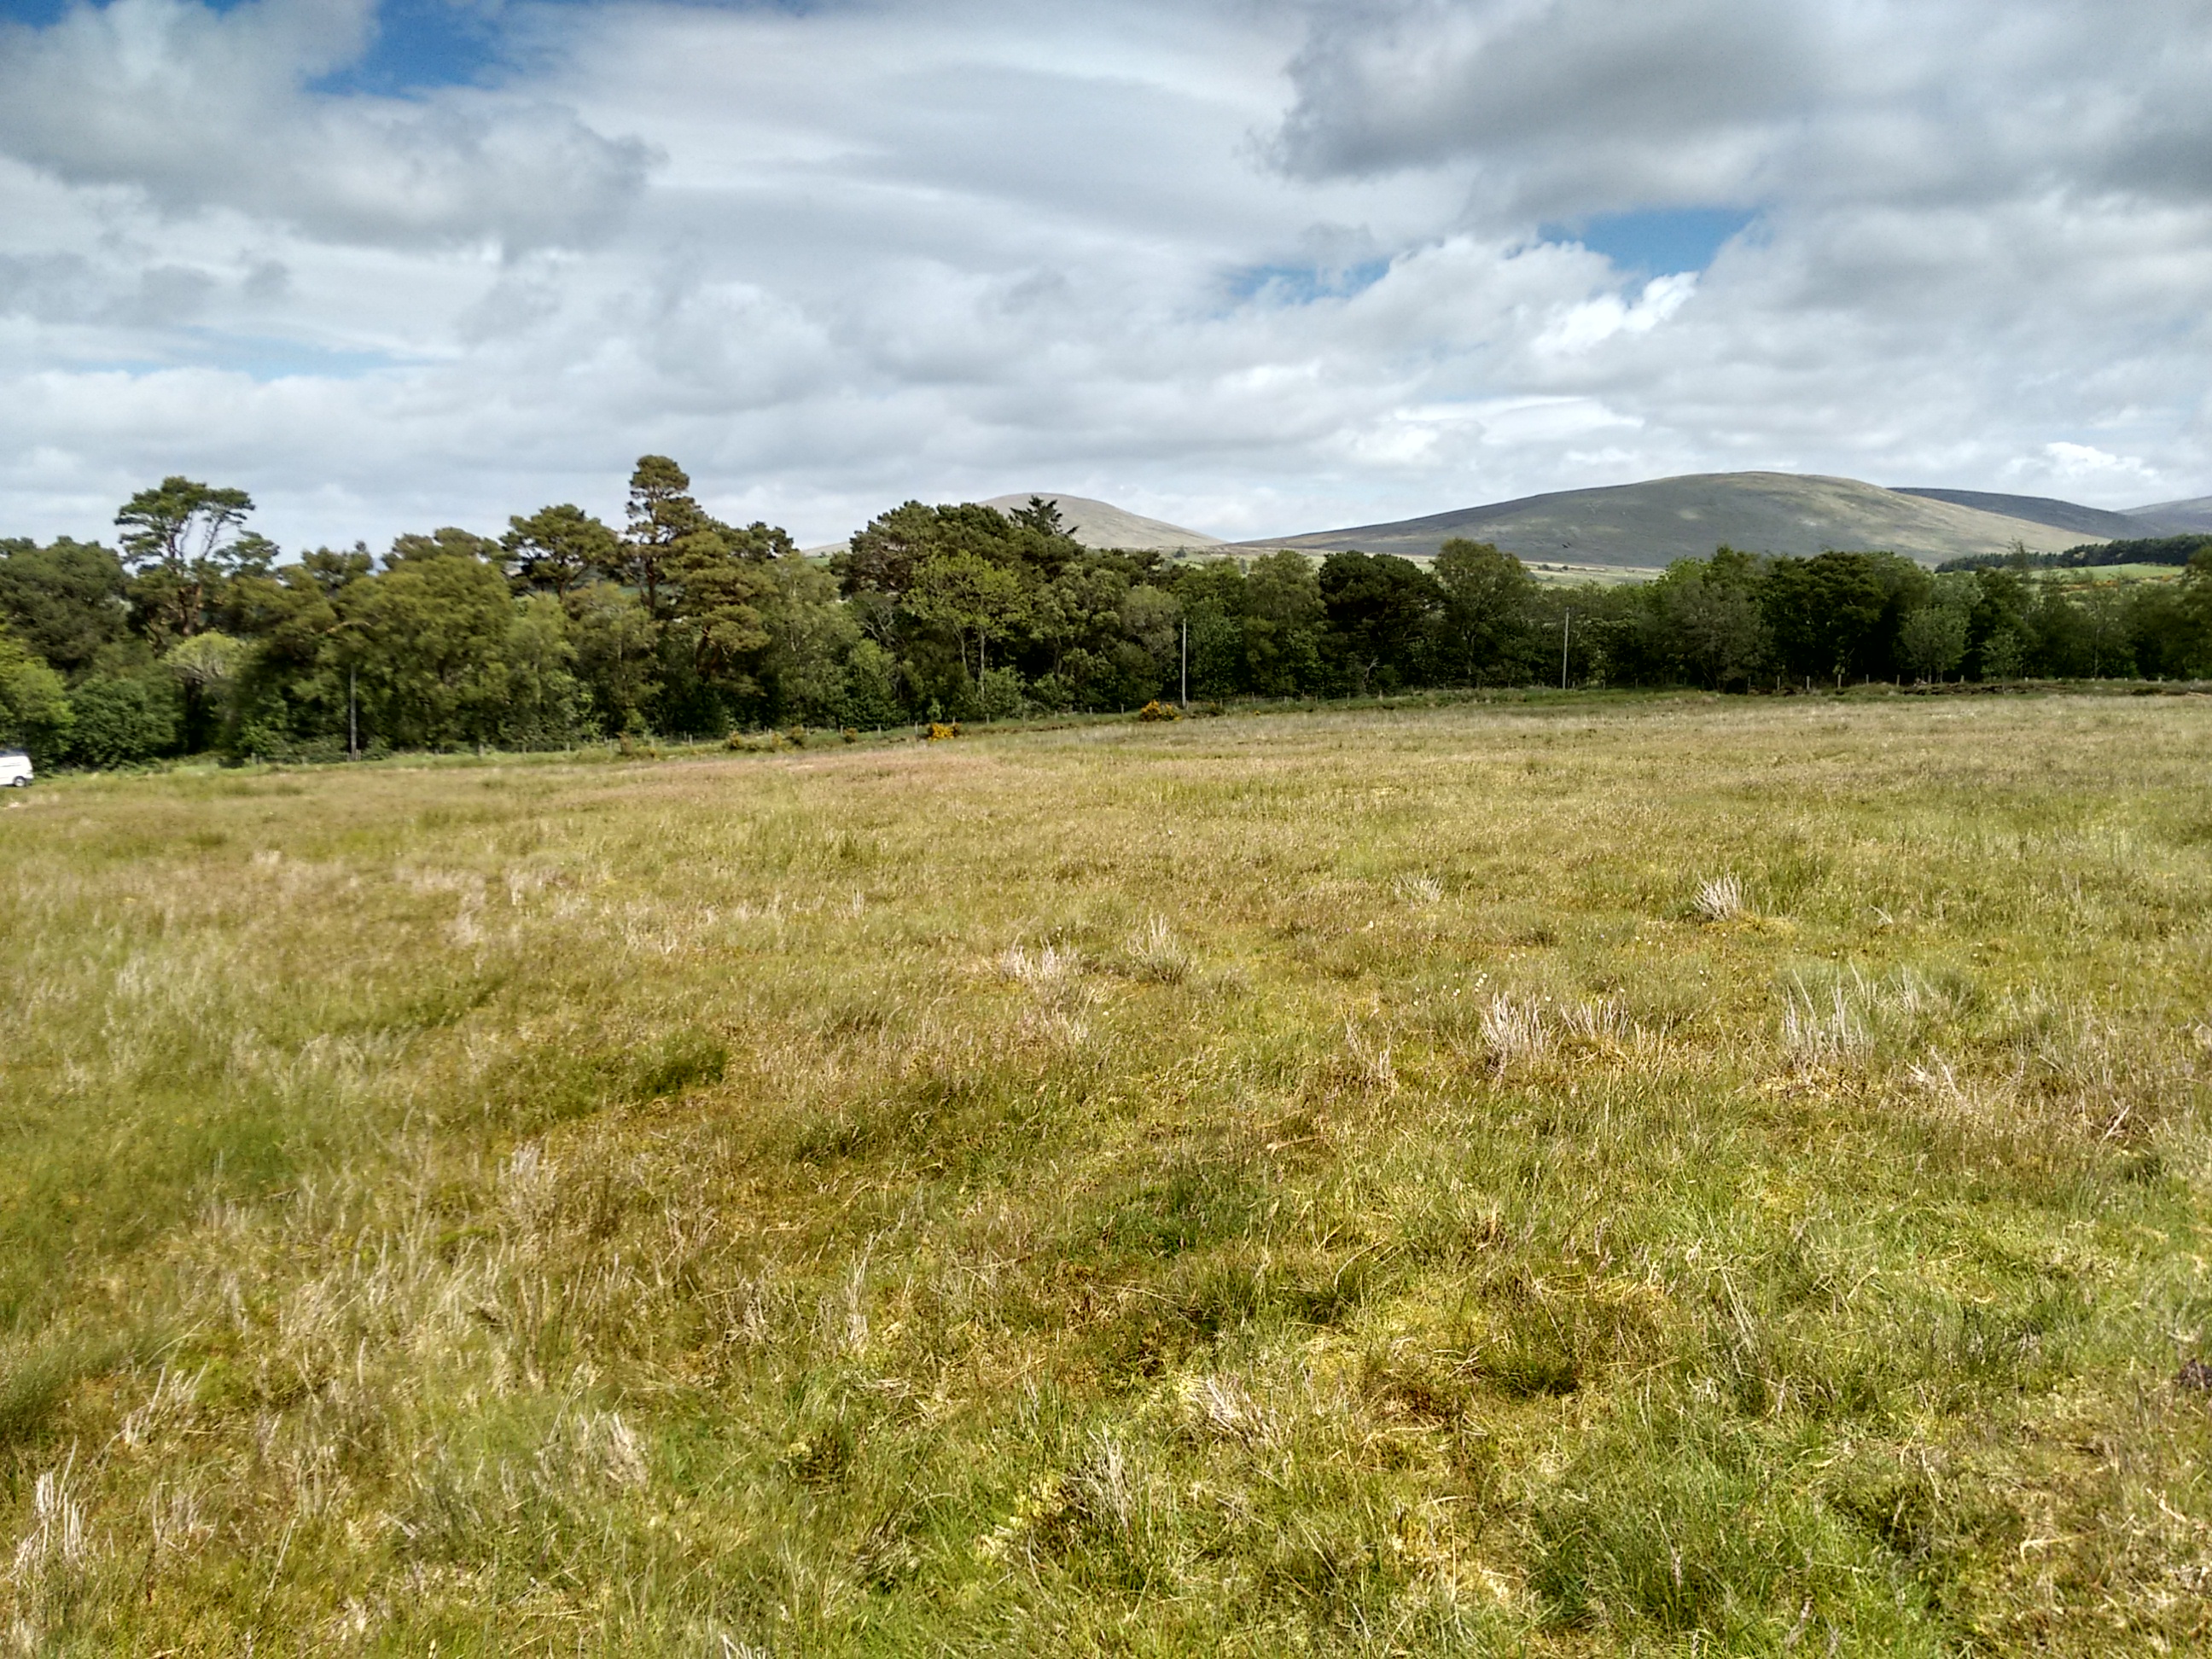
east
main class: Grassland
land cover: Grassland without tree/shrub cover
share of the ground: > 75 %
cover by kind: herbaceous plants 100 %
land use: Agriculture (excluding fallow land and kitchen gardens)
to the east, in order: Grassland without tree/shrub cover; Ditches and canals; Grassland without tree/shrub cover; Fences; Broadleaved woodland; Ditches and canals; Grass margins; Paved roads, cycling and walking lanes; Grass margins; Fences; Broadleaved woodland; Rivers and streams; Fences; Grassland without tree/shrub cover; Fences; Abandoned hedges
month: June
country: GB
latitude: 54.8466
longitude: -7.0691
